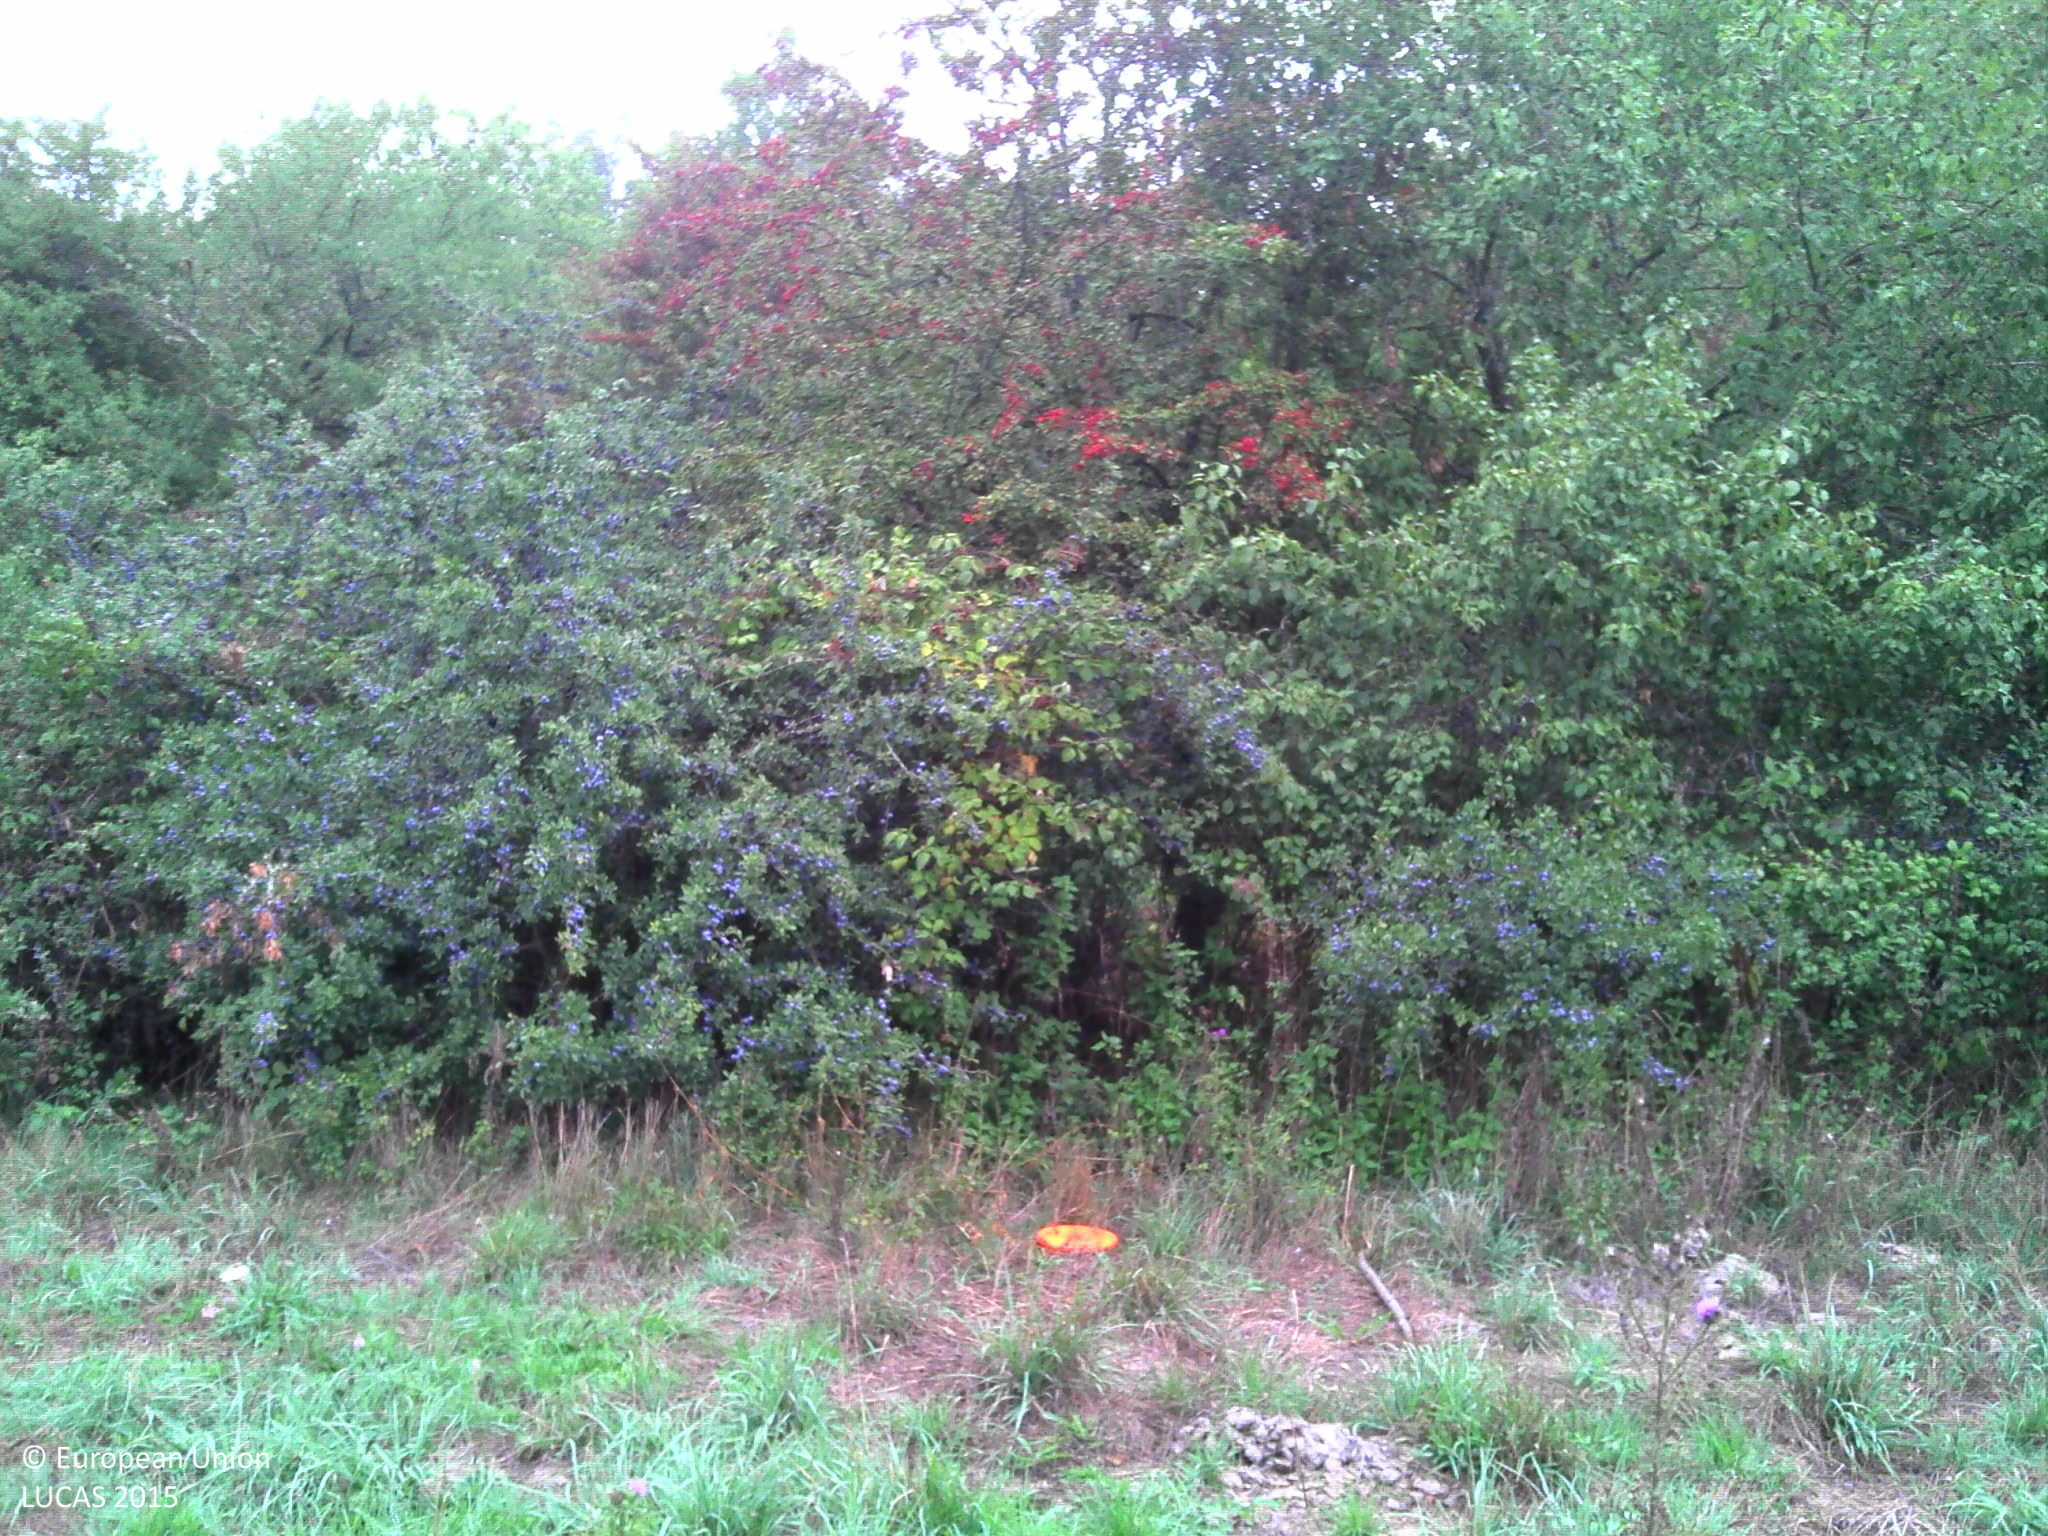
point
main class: Woodland
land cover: Broadleaved woodland
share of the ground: > 75 %
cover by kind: broadleaved forest trees 85 %, shrubs 10 %, herbaceous plants 5 %
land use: Agriculture (excluding fallow land and kitchen gardens)
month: September
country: FR
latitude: 47.6135
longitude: 4.4244
